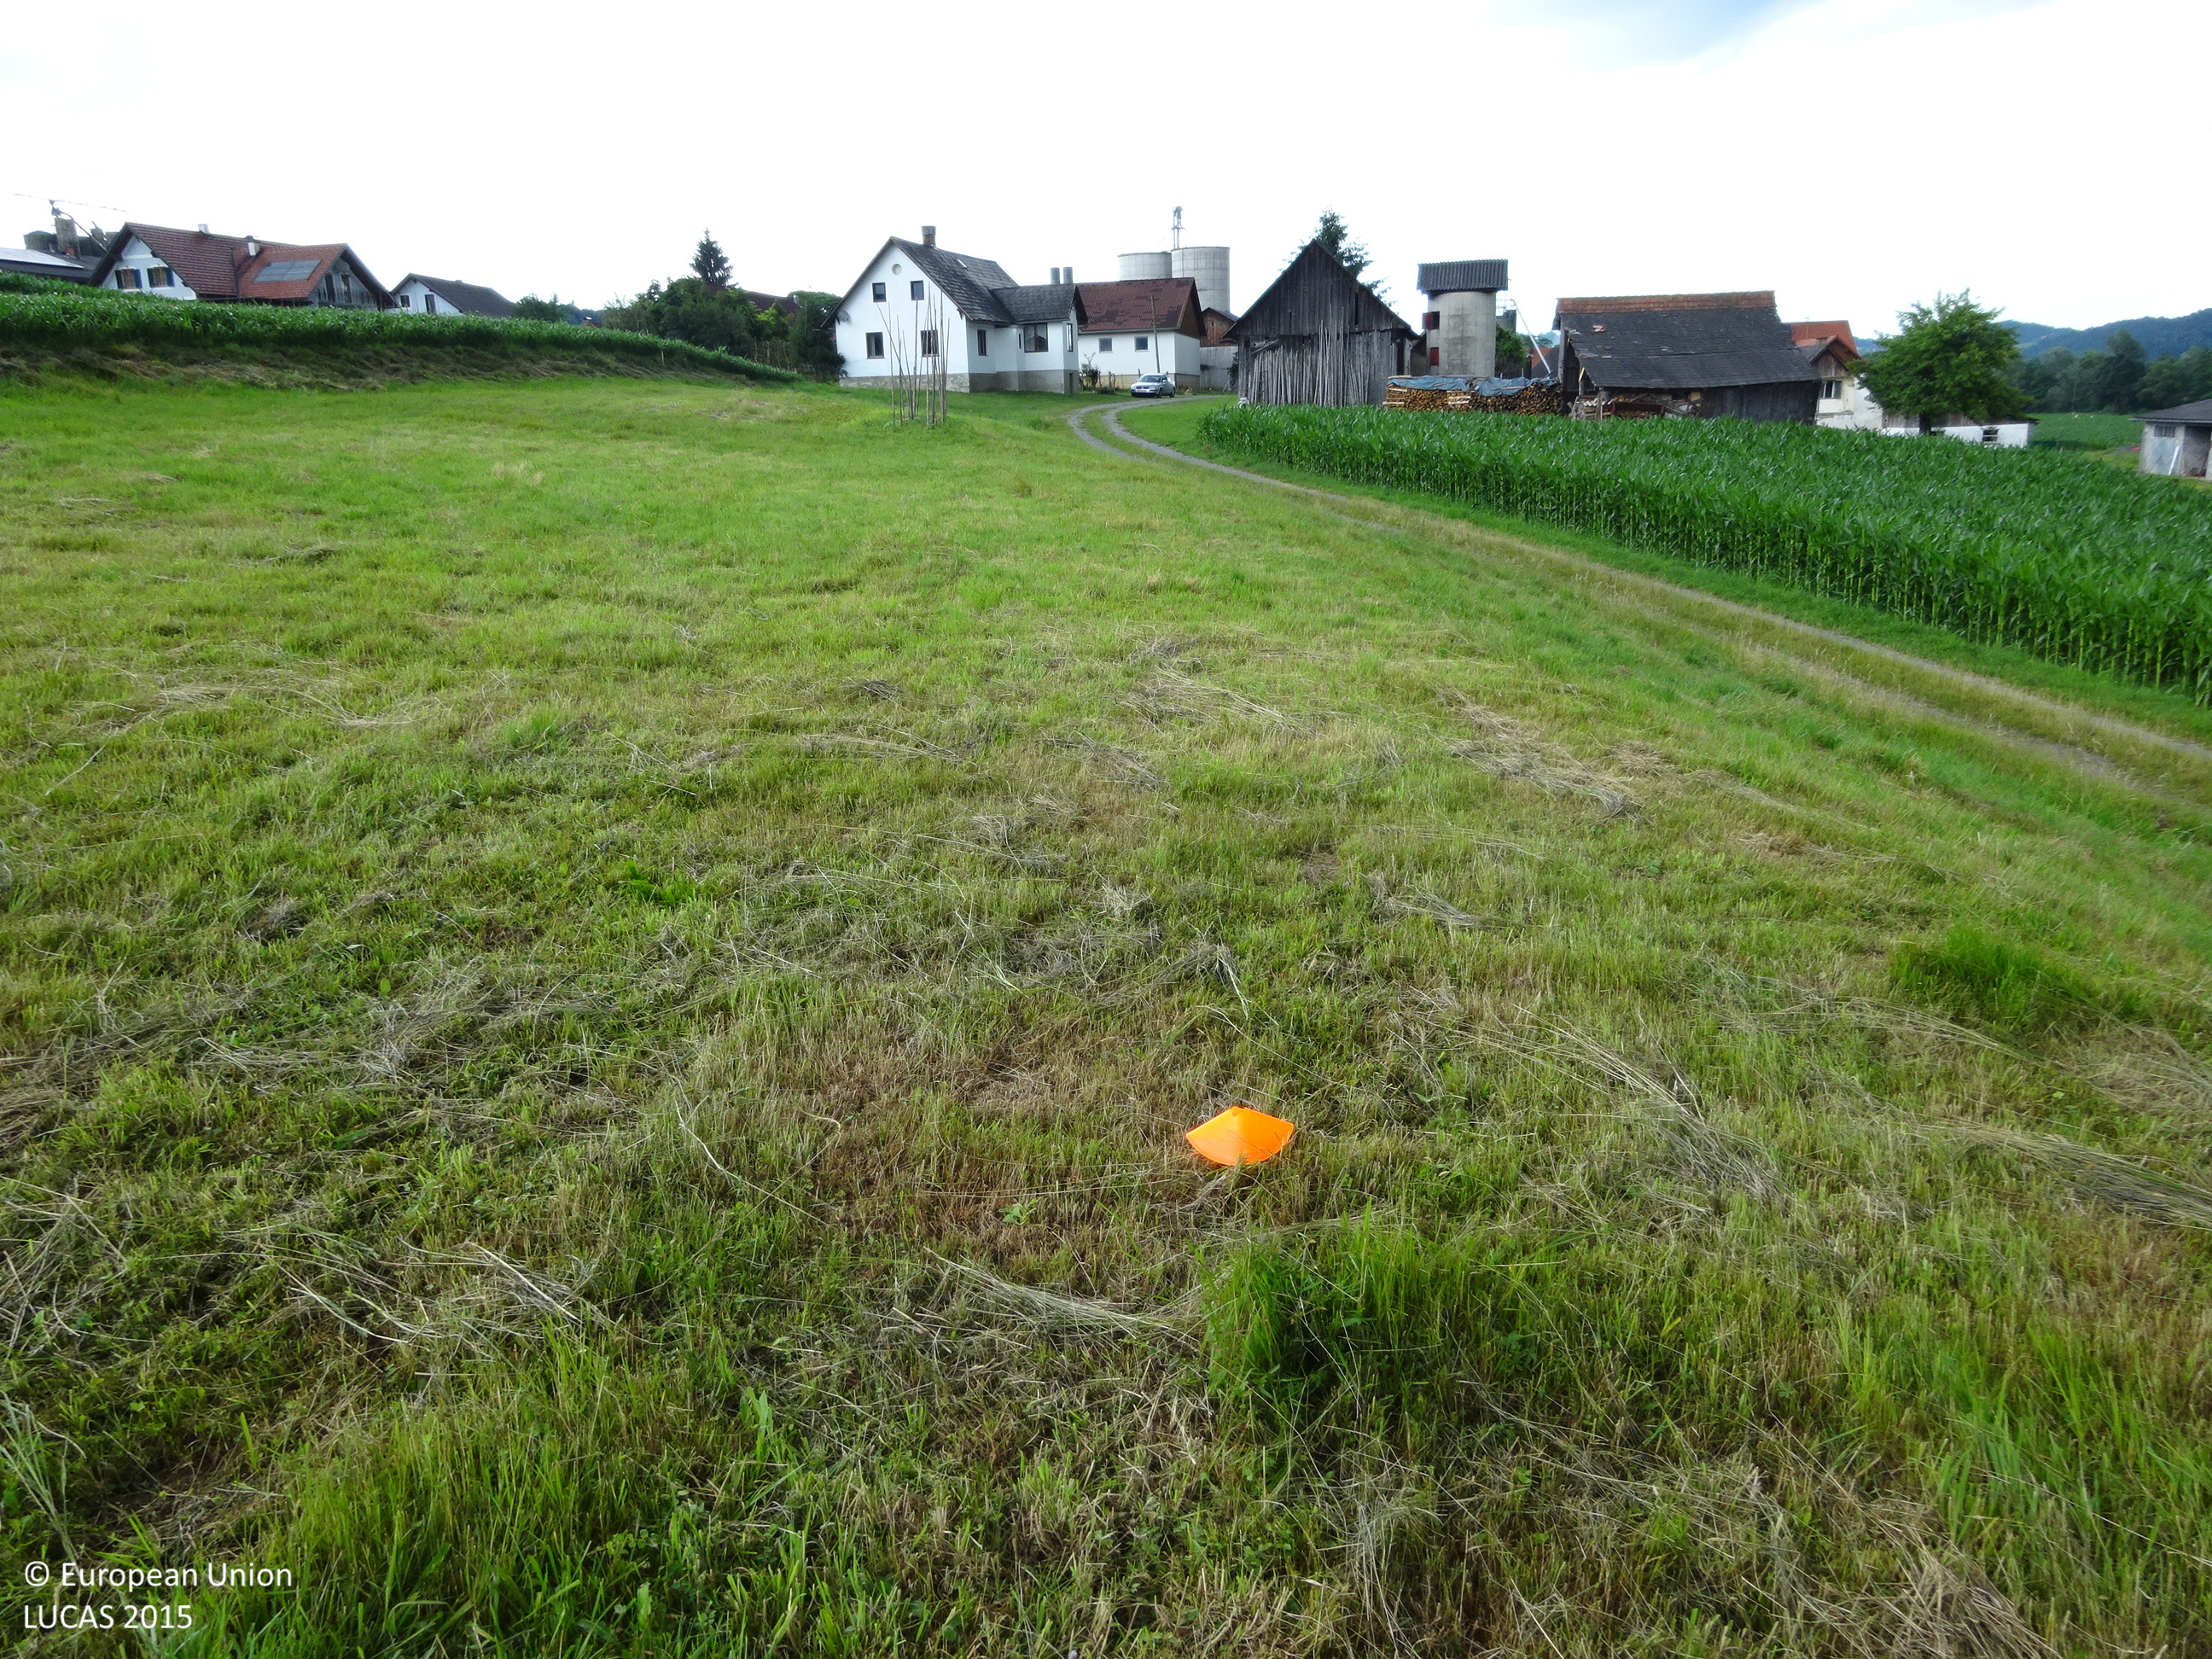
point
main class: Grassland
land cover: Grassland without tree/shrub cover
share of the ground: > 75 %
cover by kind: herbaceous plants 100 %
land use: Agriculture (excluding fallow land and kitchen gardens)
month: June
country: AT
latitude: 46.7201
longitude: 15.4023
